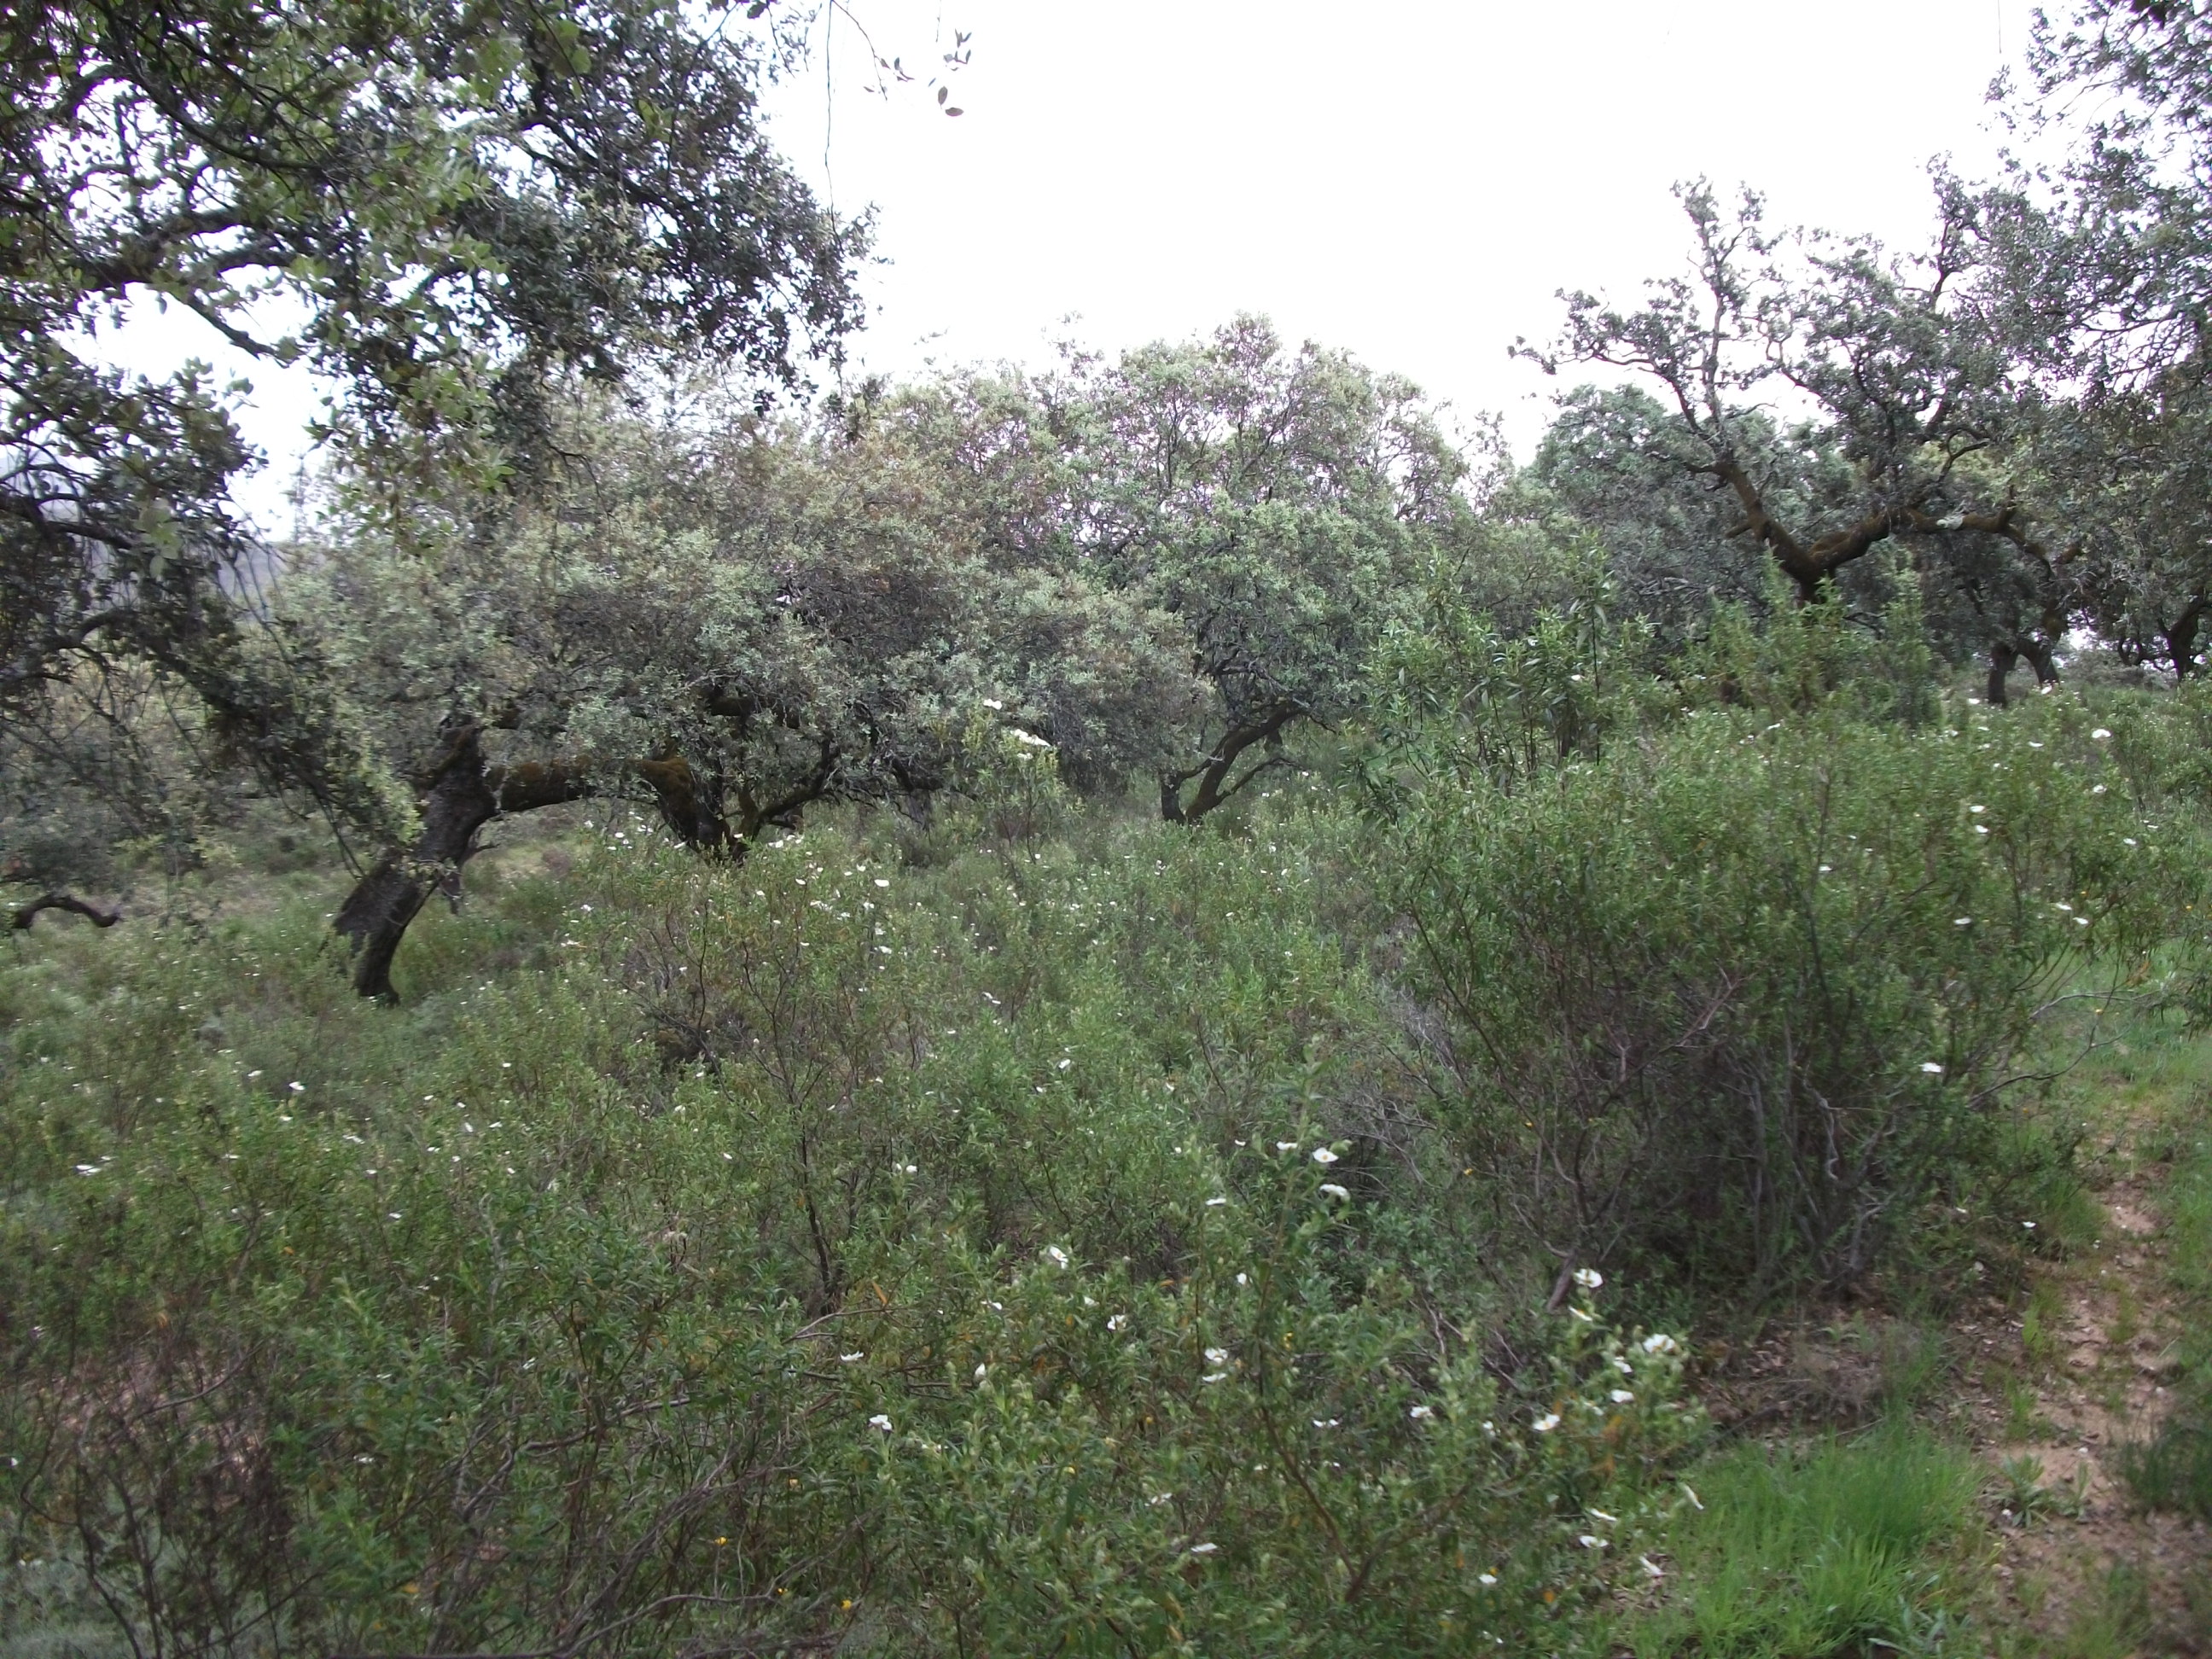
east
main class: Woodland
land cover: Broadleaved woodland
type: broadleaved evergreen forest
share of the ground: 25 - 50 %
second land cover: Shrubland without tree cover
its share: > 75 %
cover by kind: broadleaved forest trees 50 %, shrubs 45 %, herbaceous plants 5 %
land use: Forestry
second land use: Agriculture (excluding fallow land and kitchen gardens)
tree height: > 5 m
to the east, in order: Broadleaved woodland; Shrubland without tree cover; Fences; Broadleaved woodland; Fences; Broadleaved woodland
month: April
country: ES
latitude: 37.8403
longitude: -6.7384
